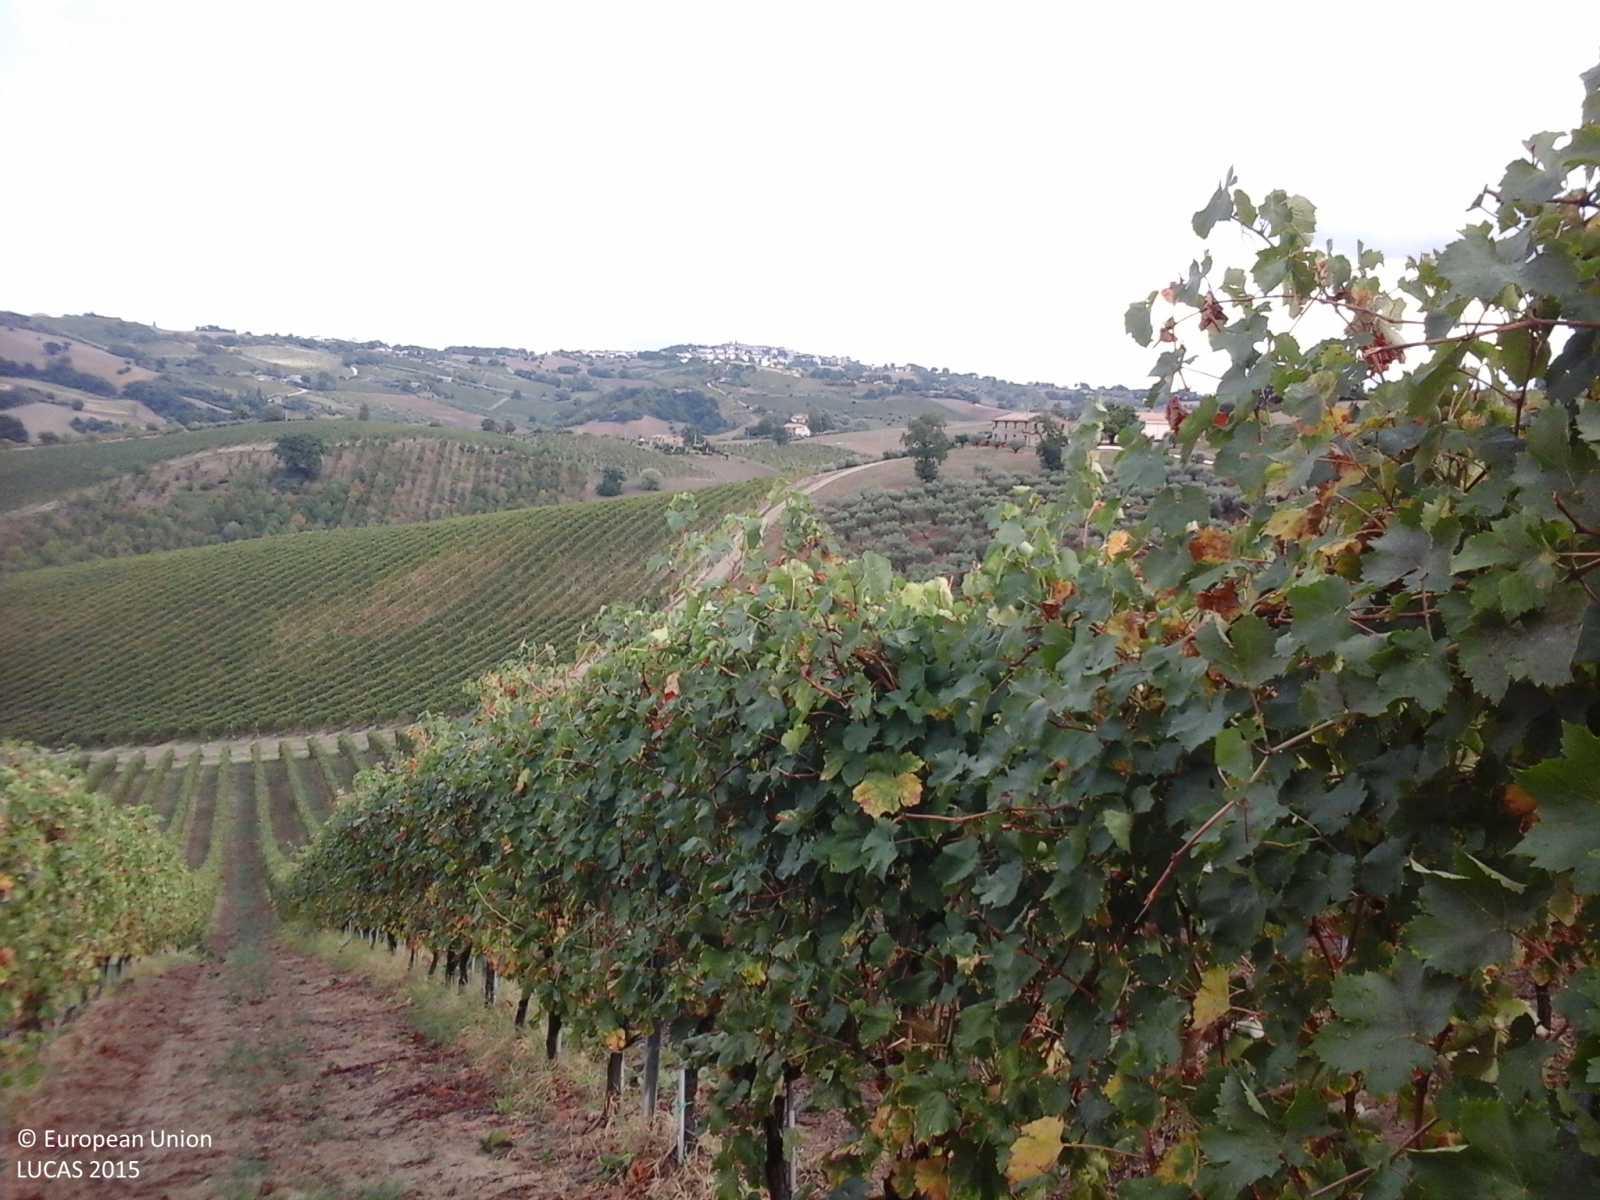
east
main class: Cropland
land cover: Vineyards
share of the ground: 50 - 75 %
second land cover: Other bare soil
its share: > 75 %
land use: Agriculture (excluding fallow land and kitchen gardens)
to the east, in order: Vineyards; Other bare soil; Ditches and canals; Tracks; Vineyards
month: September
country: IT
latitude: 43.4364
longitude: 13.1424
